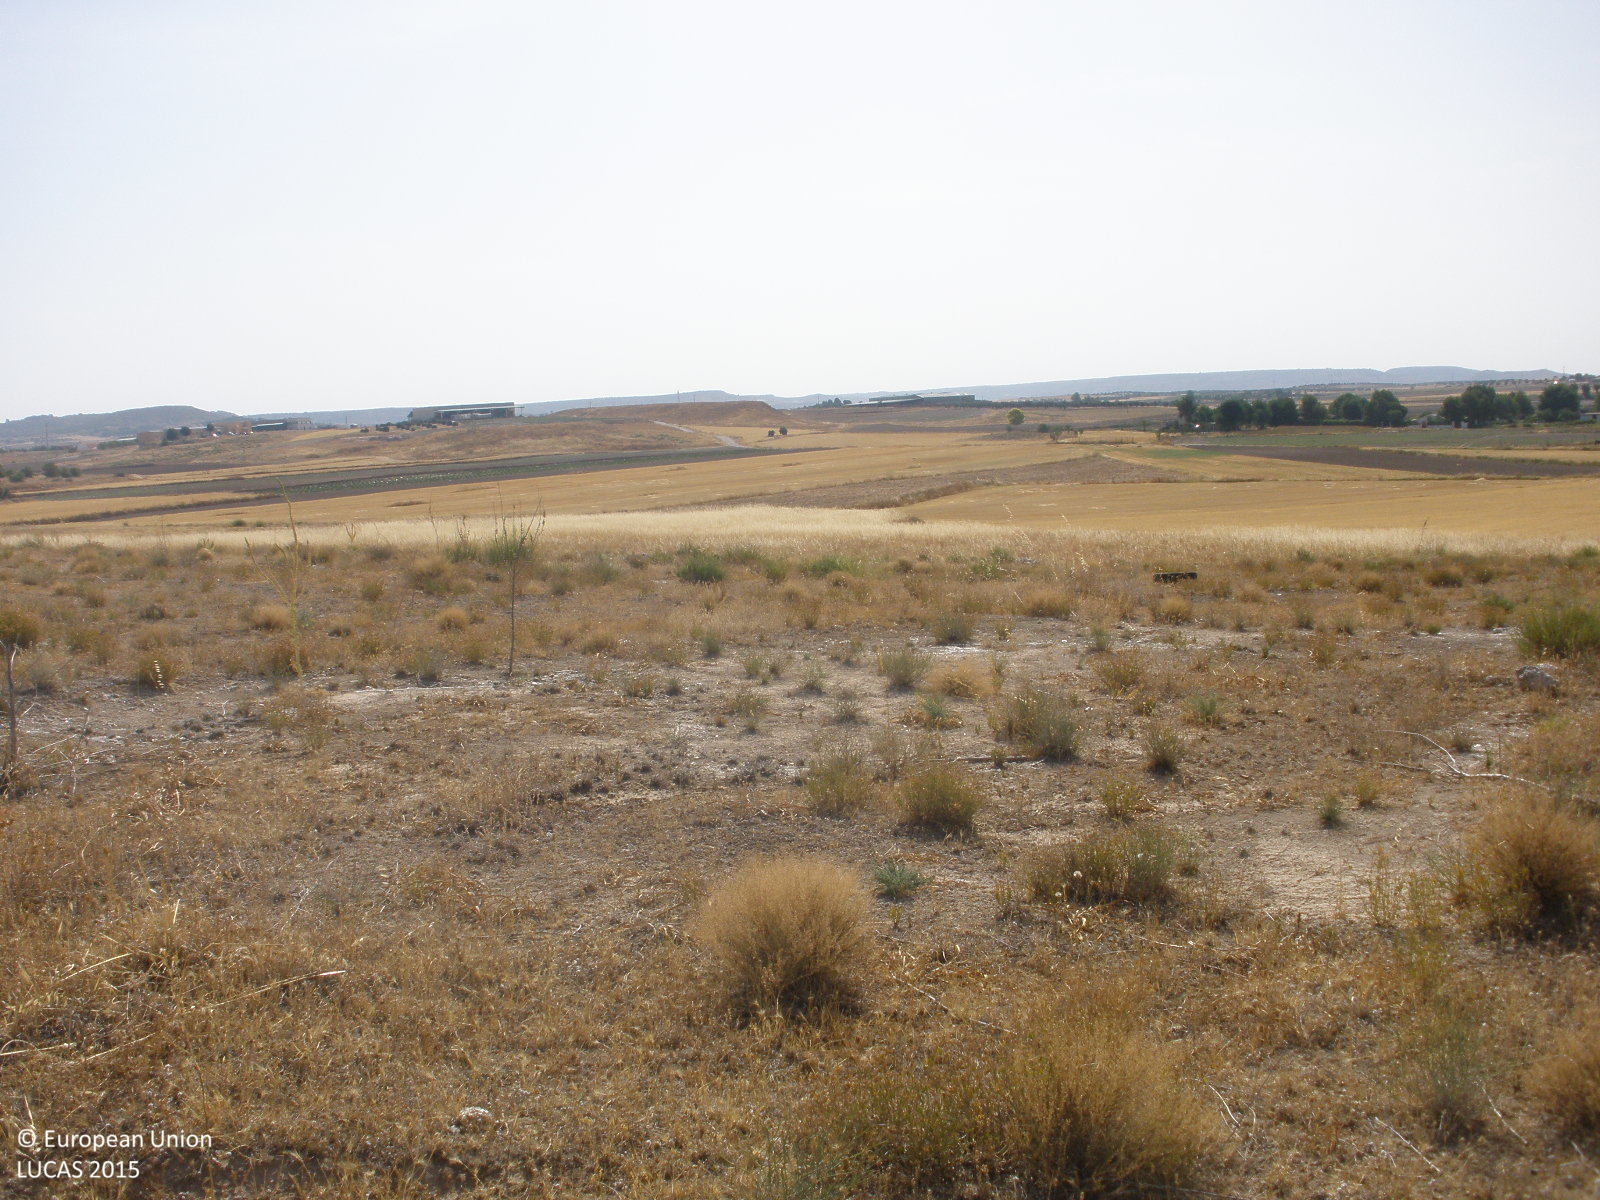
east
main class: Shrubland
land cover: Shrubland without tree cover
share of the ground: 25 - 50 %
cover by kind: herbaceous plants 50 %, shrubs 30 %, consolidated bare surface 20 %
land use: Semi-natural and natural areas not in use
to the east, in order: Tracks; Shrubland without tree cover; Tracks; Shrubland without tree cover; Dry stone walls; Spontaneously vegetated surfaces; Grass margins; Barley; Grass margins; Other bare soil
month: July
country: ES
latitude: 40.0976
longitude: -3.5086
